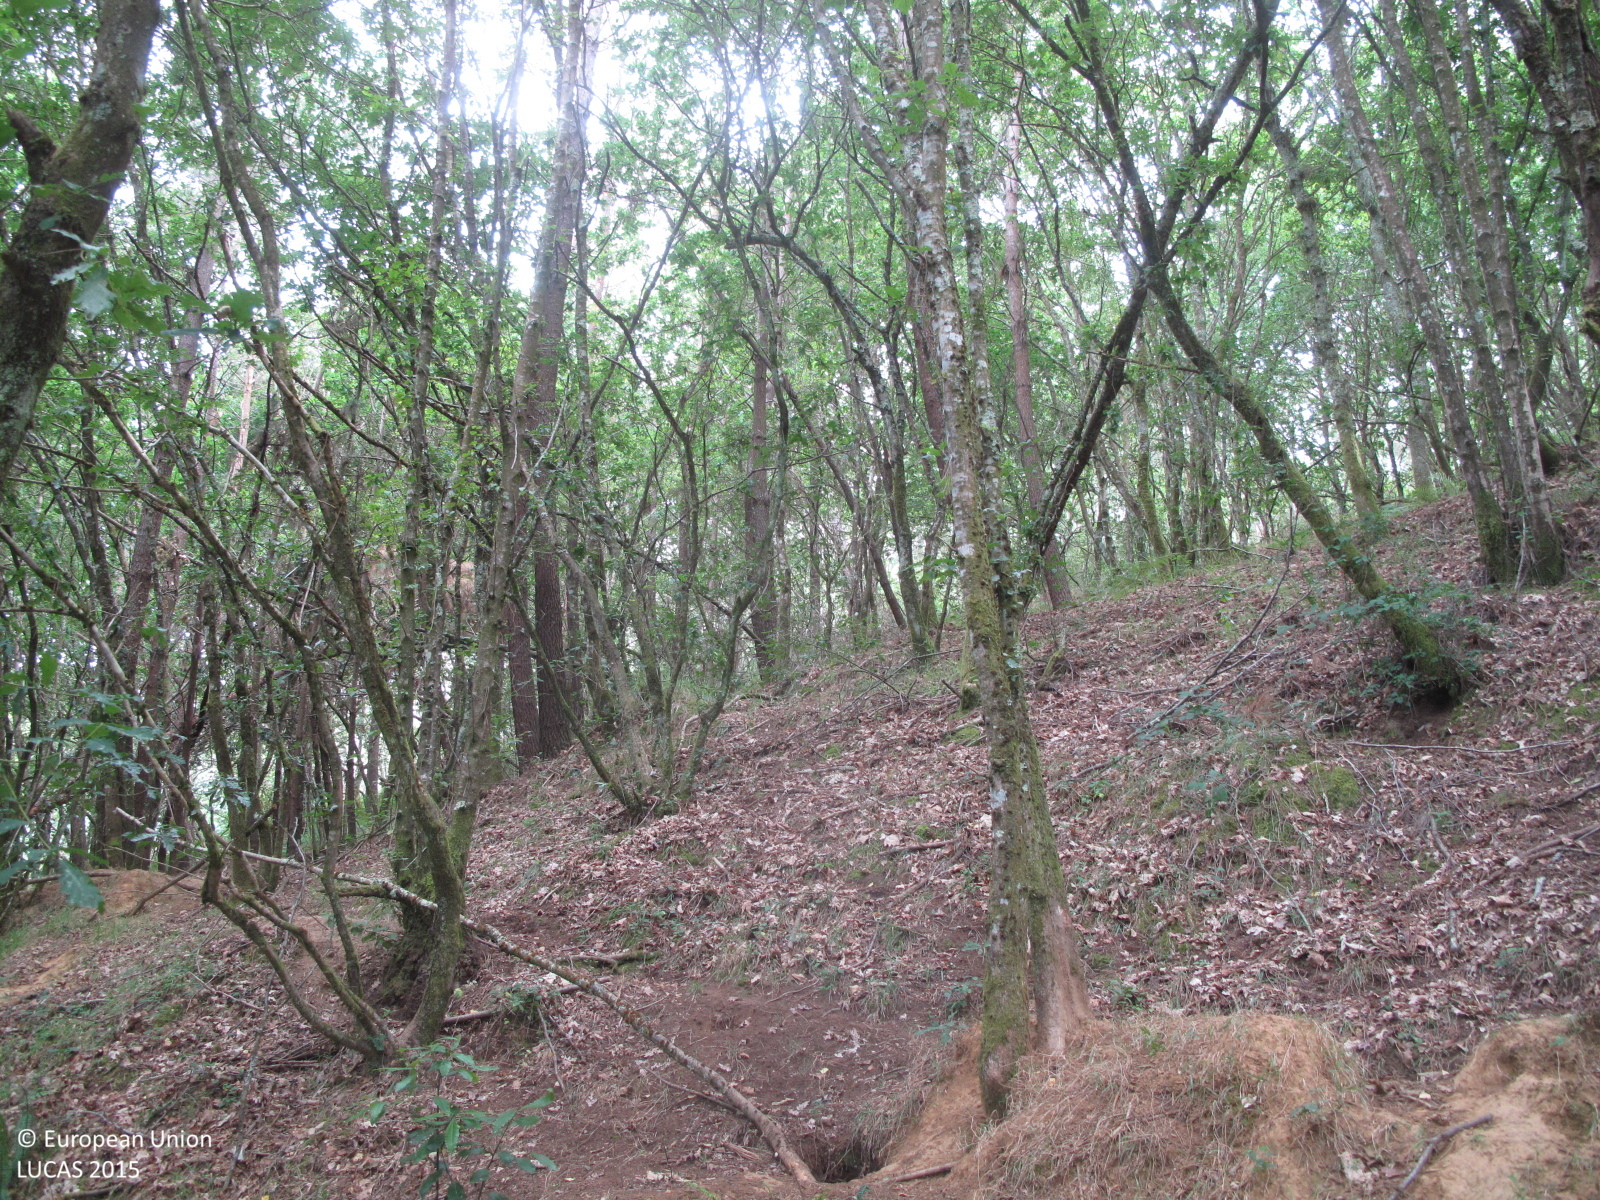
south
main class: Woodland
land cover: Broadleaved woodland
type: acidophilous oak and oak-birch forest
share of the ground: > 75 %
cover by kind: broadleaved forest trees 90 %, herbaceous plants 10 %
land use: Forestry
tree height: > 5 m
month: July
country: ES
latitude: 43.2123
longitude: -8.2563
